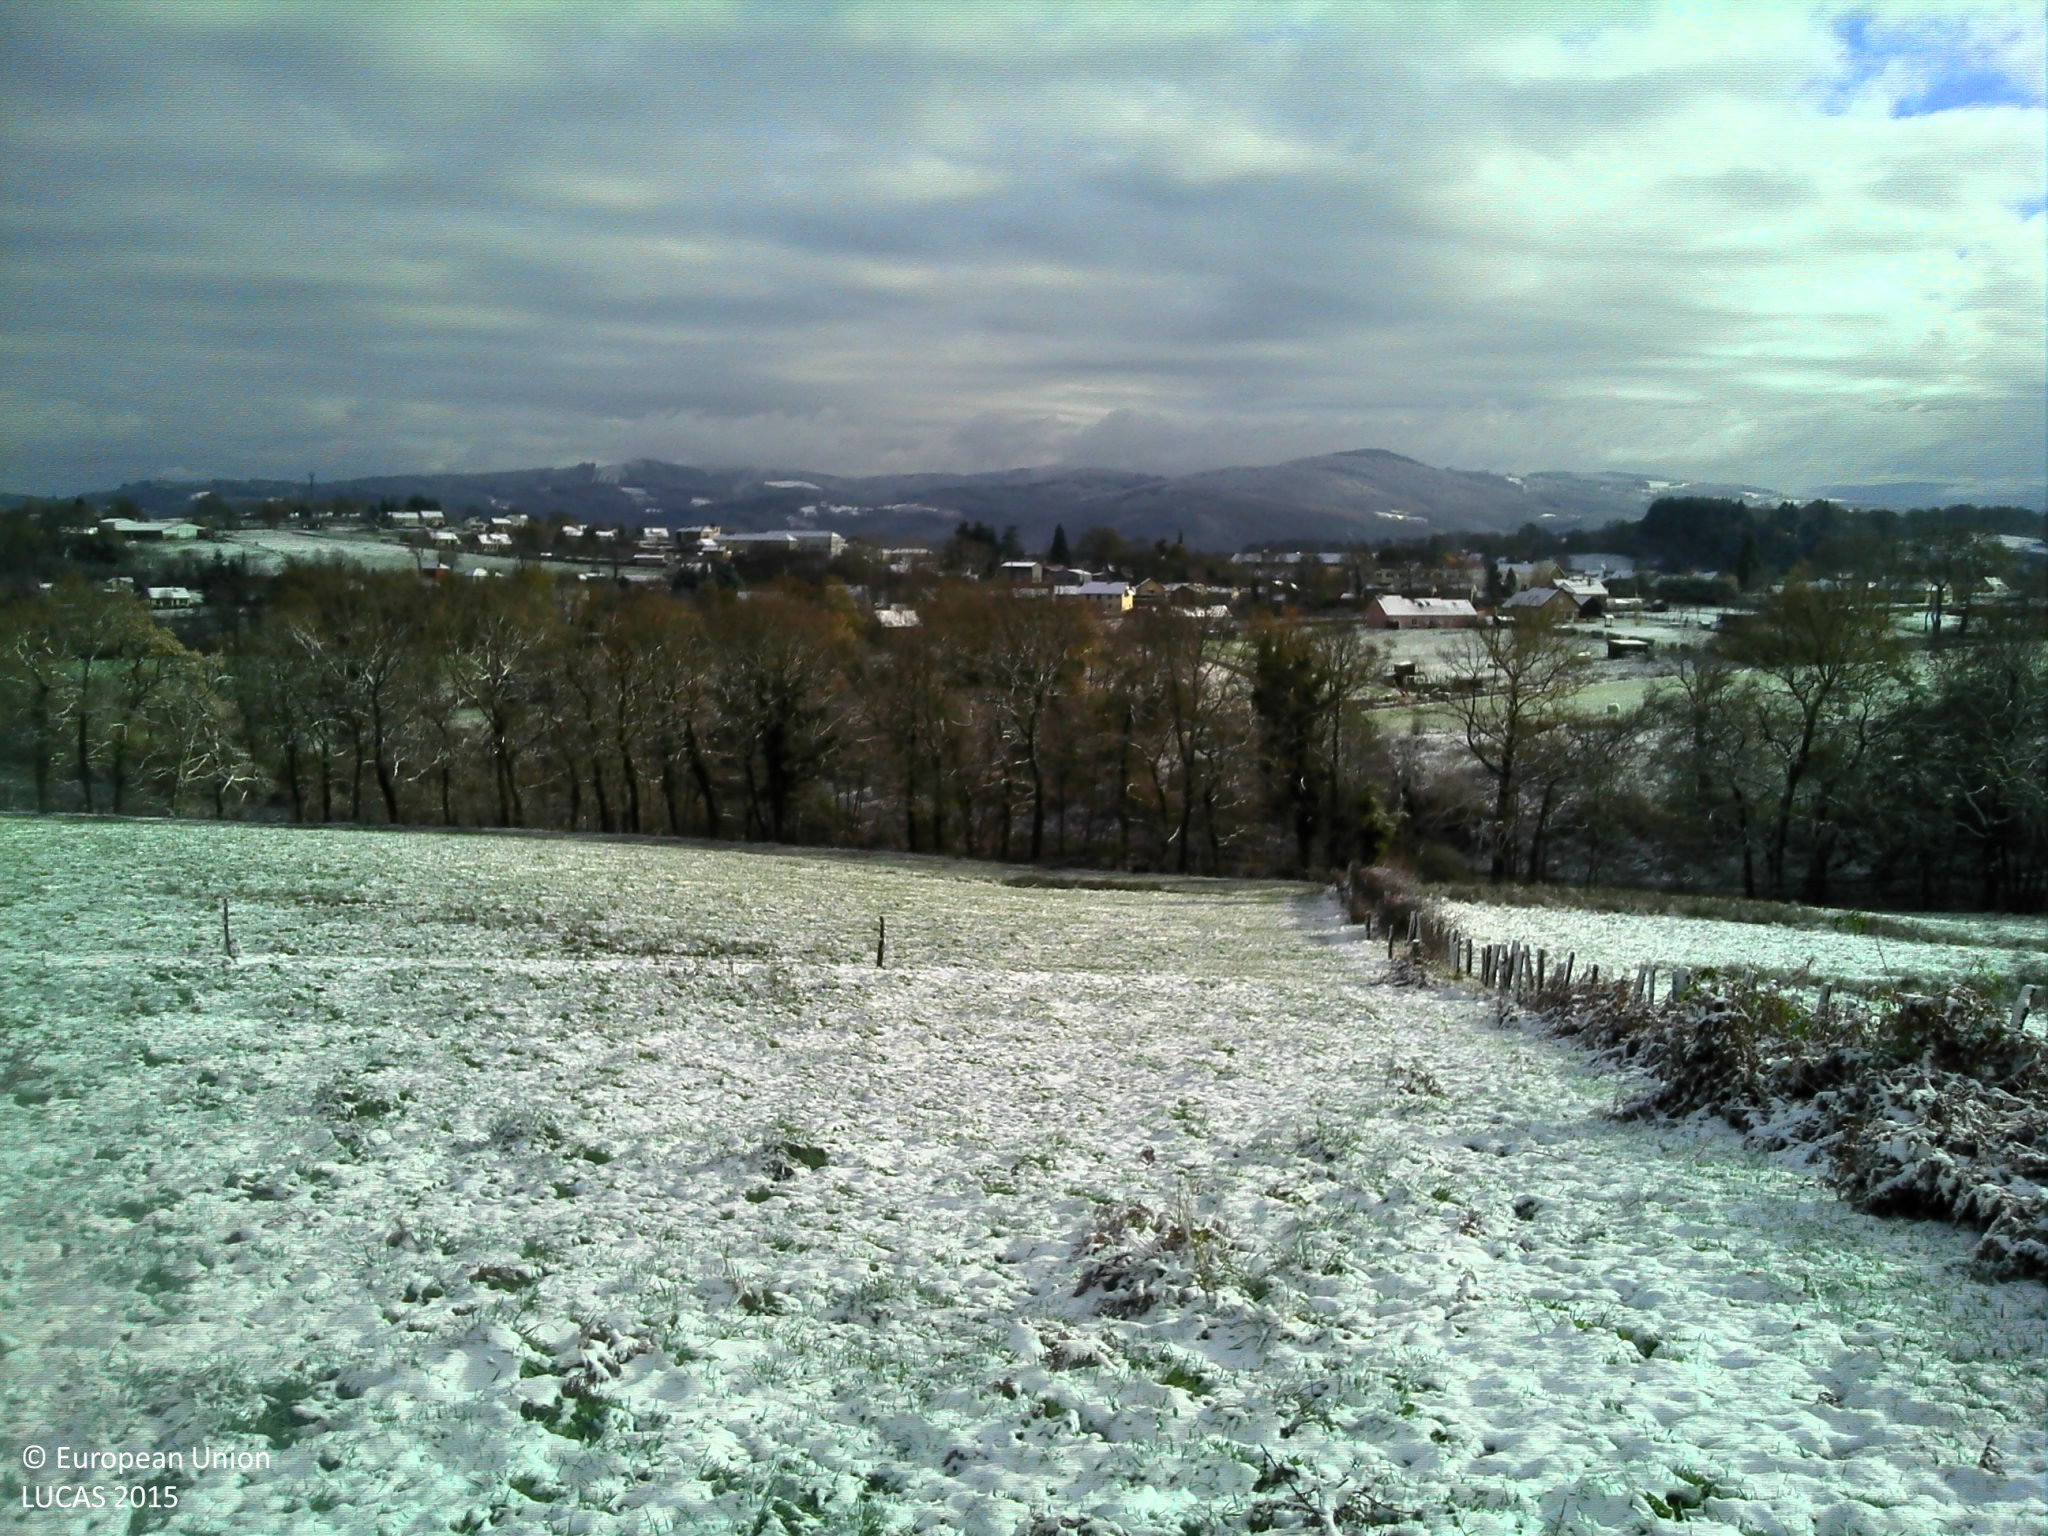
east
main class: Grassland
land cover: Grassland without tree/shrub cover
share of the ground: > 75 %
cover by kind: herbaceous plants 100 %
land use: Agriculture (excluding fallow land and kitchen gardens)
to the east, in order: Grassland without tree/shrub cover; Fences; Grassland without tree/shrub cover; Fences; Broadleaved woodland; Rivers and streams; Broadleaved woodland; Tracks; Broadleaved woodland; Spontaneously vegetated surfaces; Grassland with sparse tree/shrub cover; Shrubland with sparse tree cover; Fences; Grassland without tree/shrub cover
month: November
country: FR
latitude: 46.0723
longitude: 3.6522
